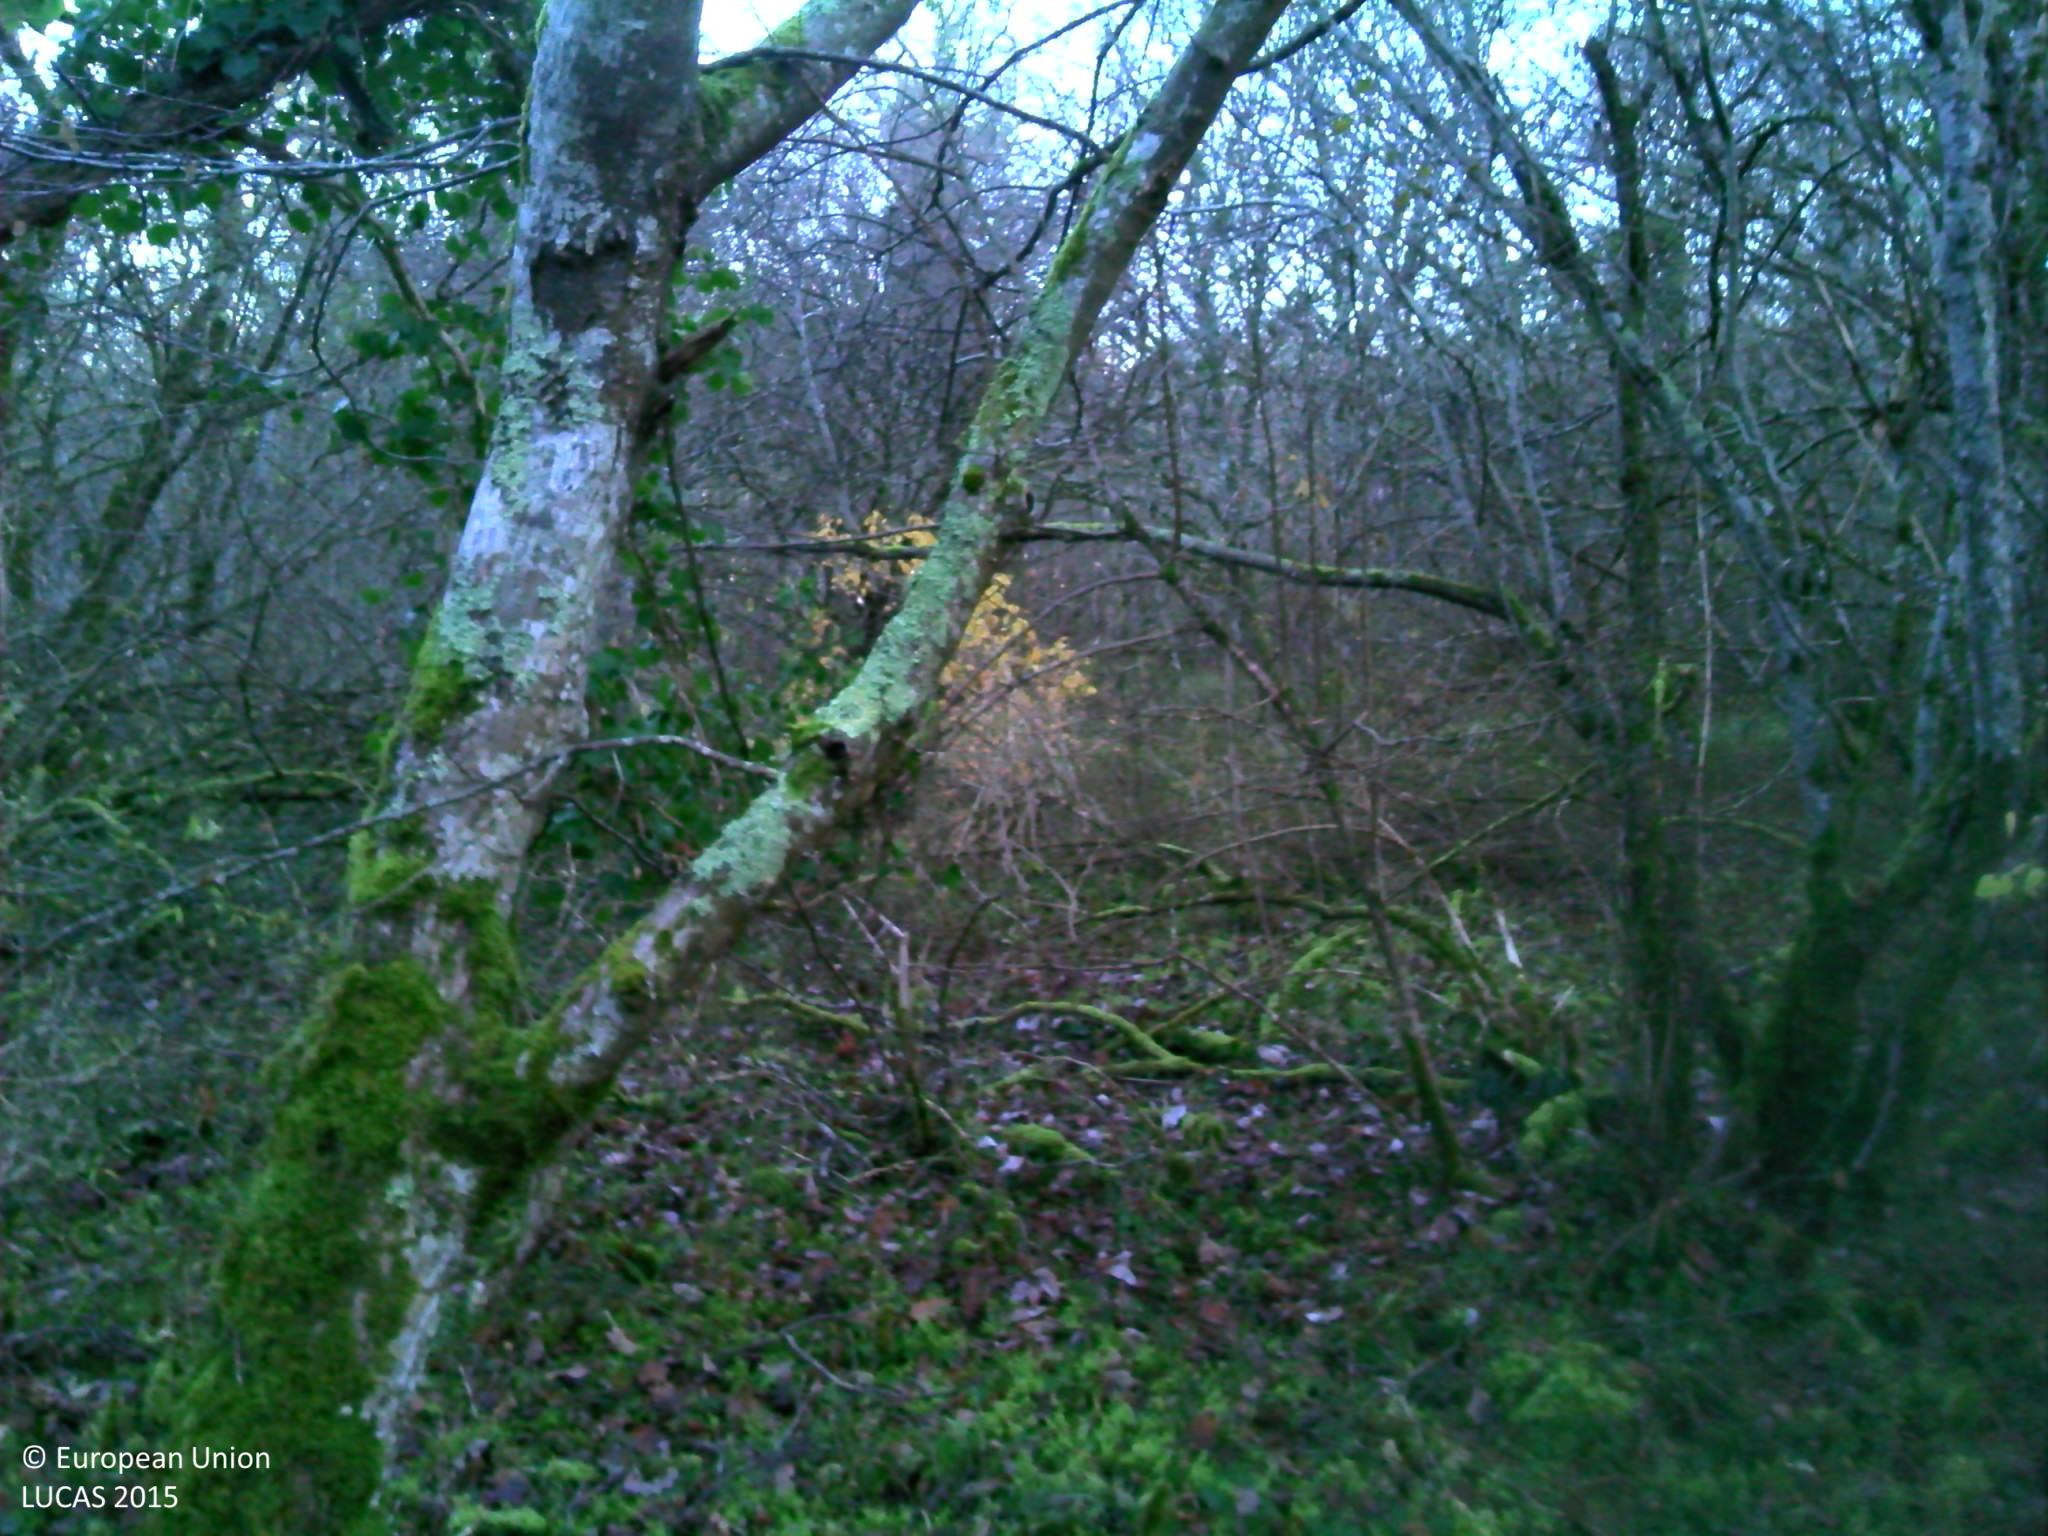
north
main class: Woodland
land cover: Broadleaved woodland
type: mesophytic deciduous forest
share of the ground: > 75 %
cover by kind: broadleaved forest trees 100 %
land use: Forestry
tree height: > 5 m
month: December
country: FR
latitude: 47.3829
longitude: 3.5193
